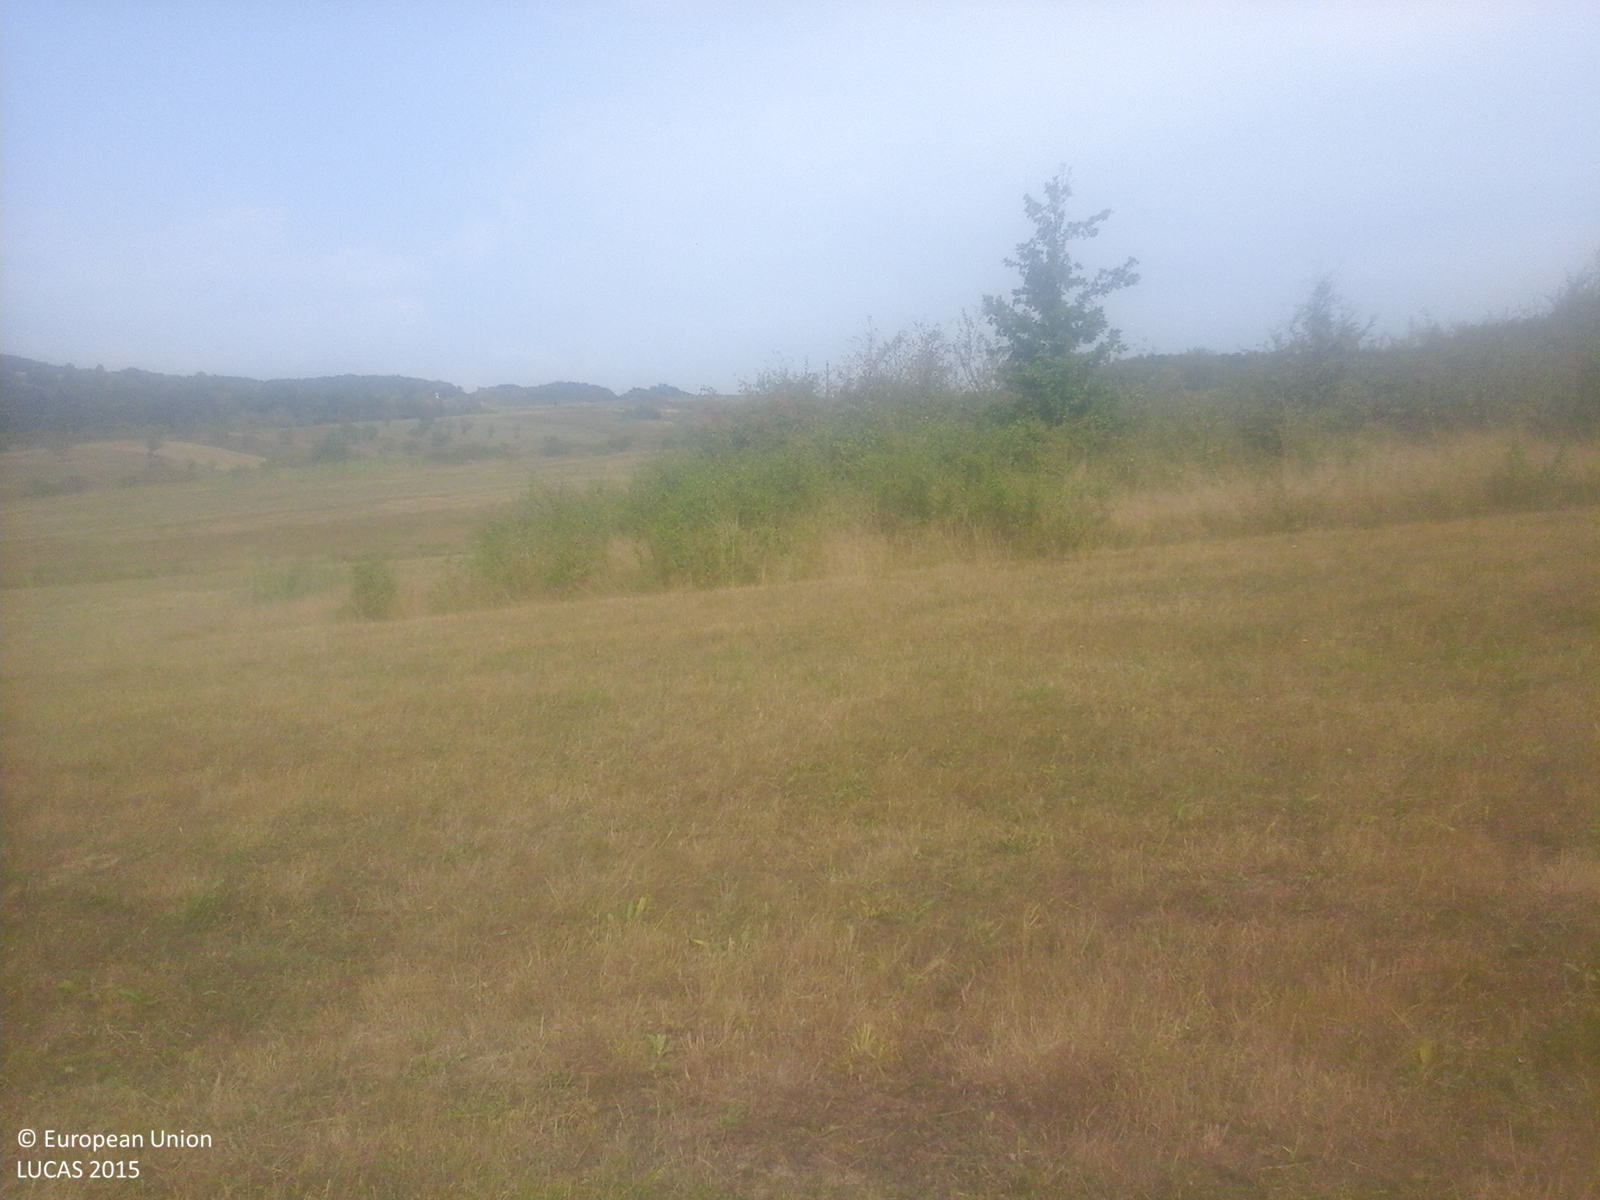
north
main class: Grassland
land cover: Grassland without tree/shrub cover
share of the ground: > 75 %
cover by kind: herbaceous plants 100 %
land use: Agriculture (excluding fallow land and kitchen gardens)
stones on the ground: < 10 %
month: September
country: RO
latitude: 47.4765
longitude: 23.8132
